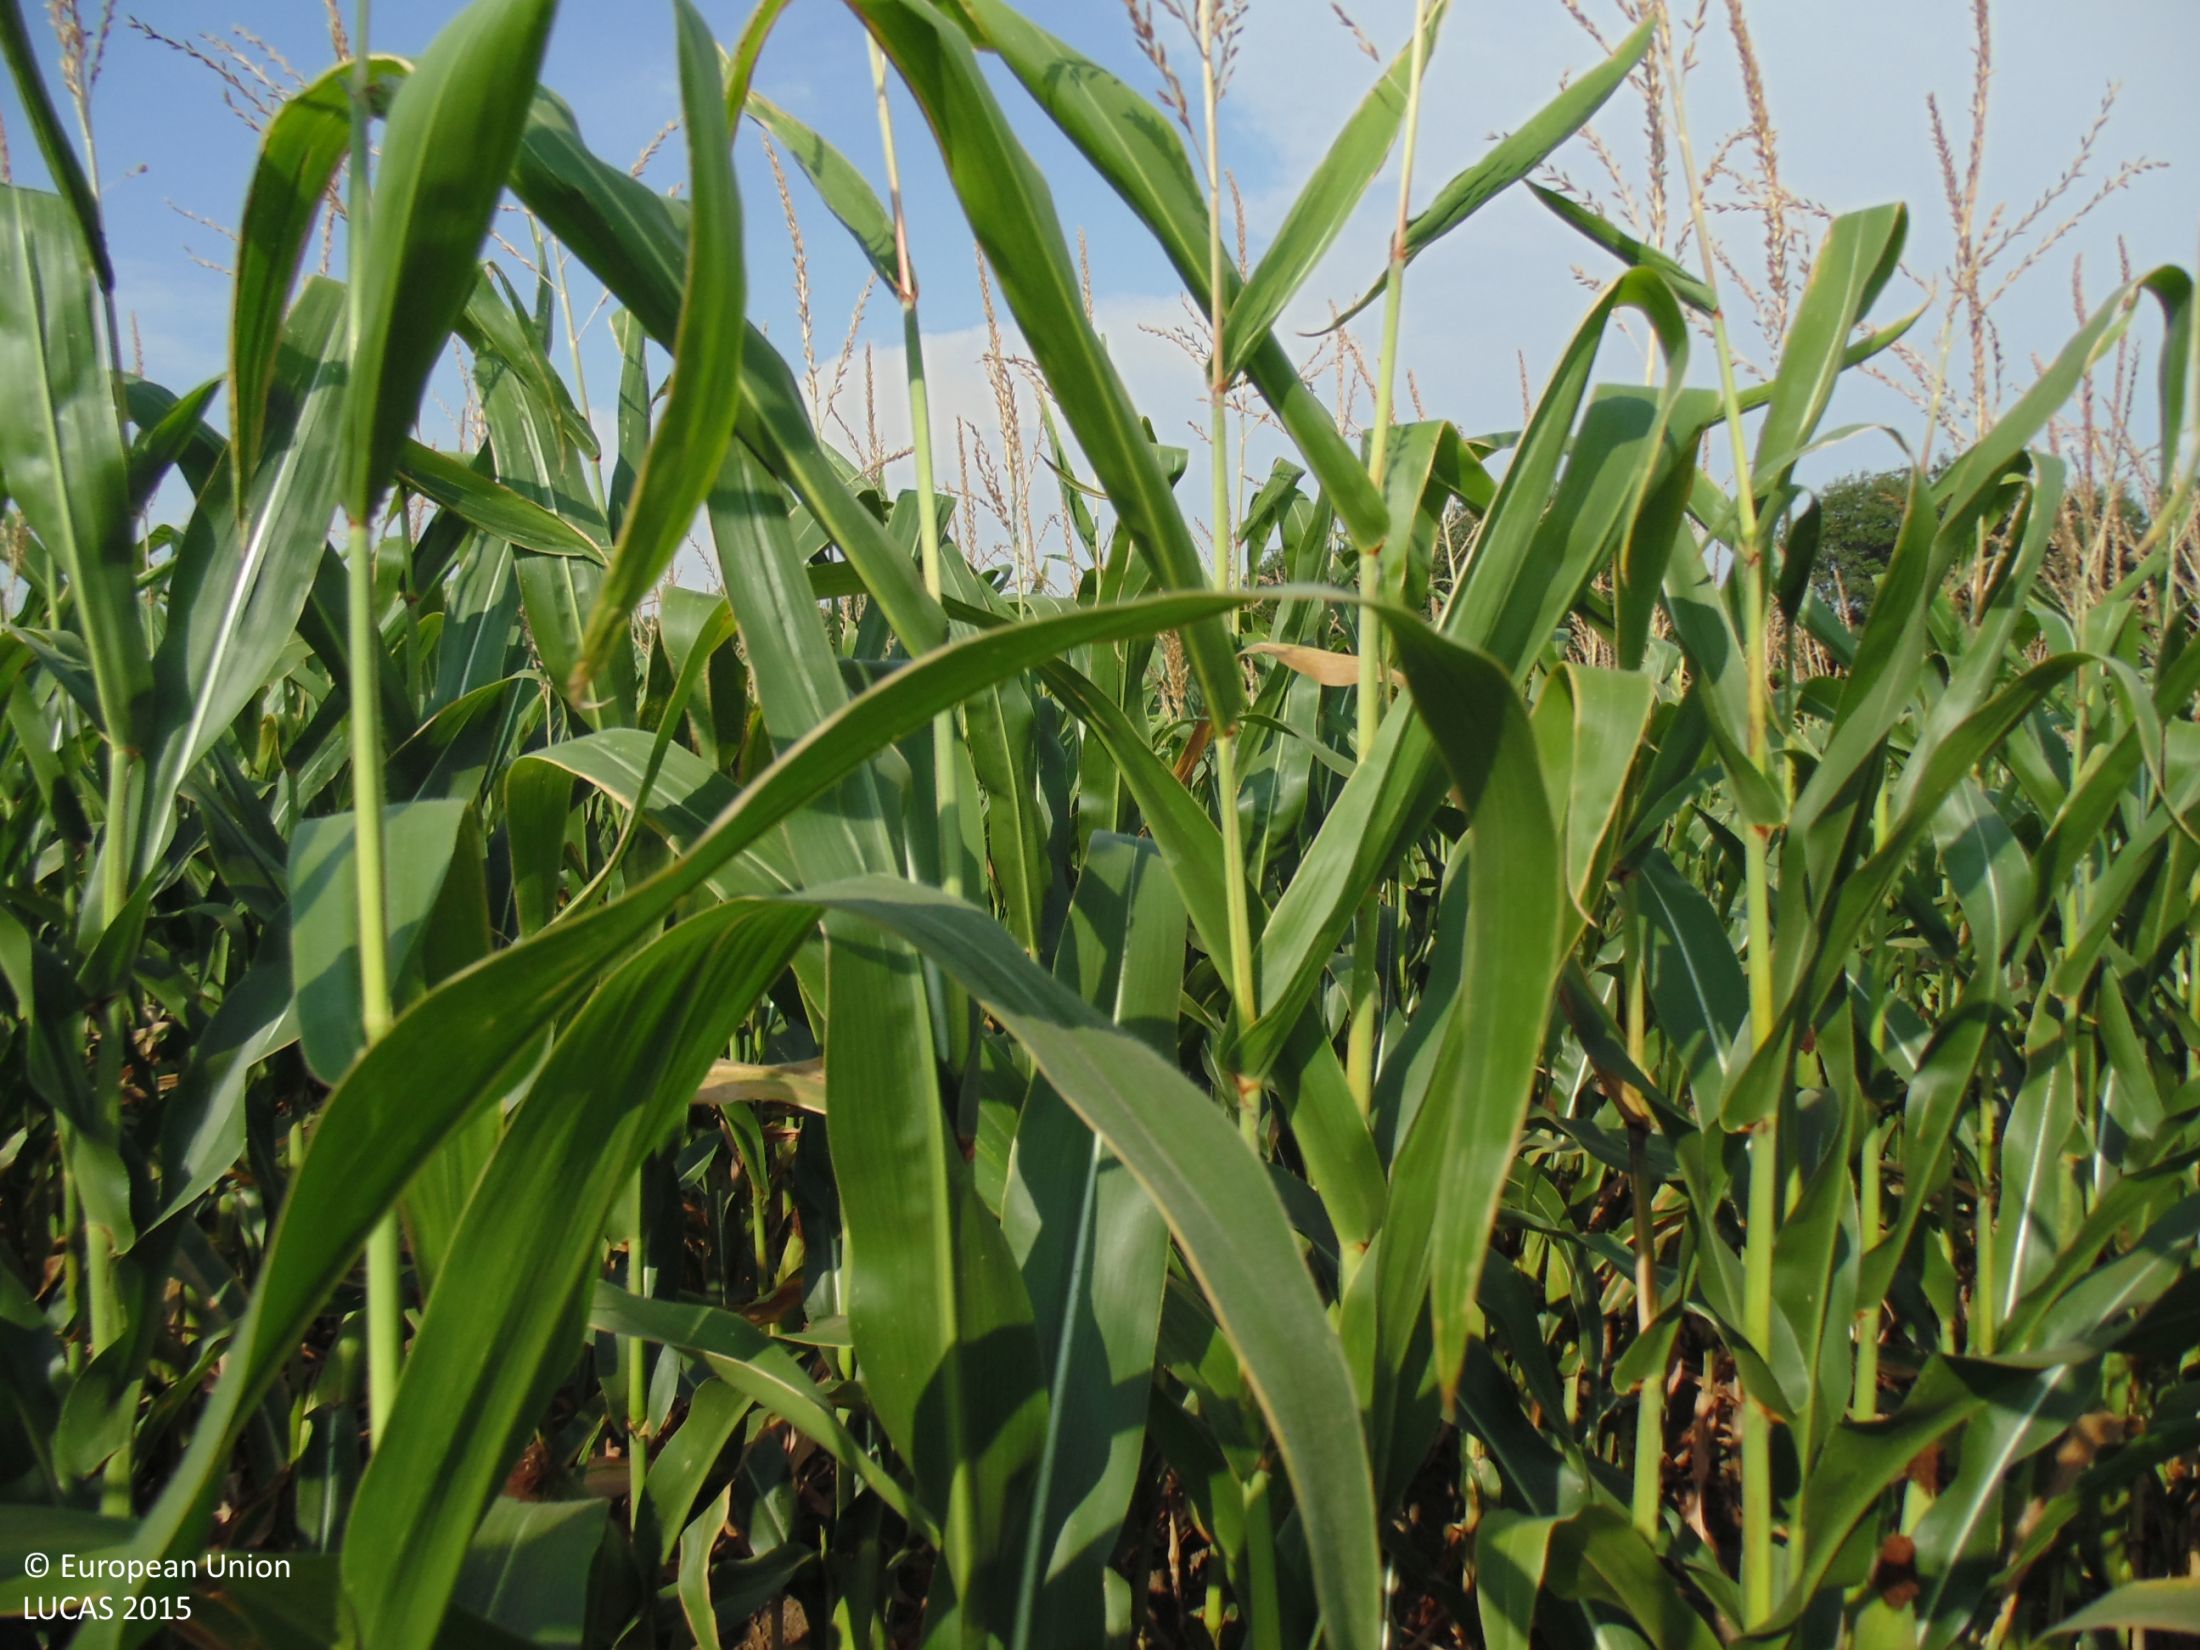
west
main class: Cropland
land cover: Maize
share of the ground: > 75 %
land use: Agriculture (excluding fallow land and kitchen gardens)
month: August
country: BG
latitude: 43.8009
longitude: 28.0620
